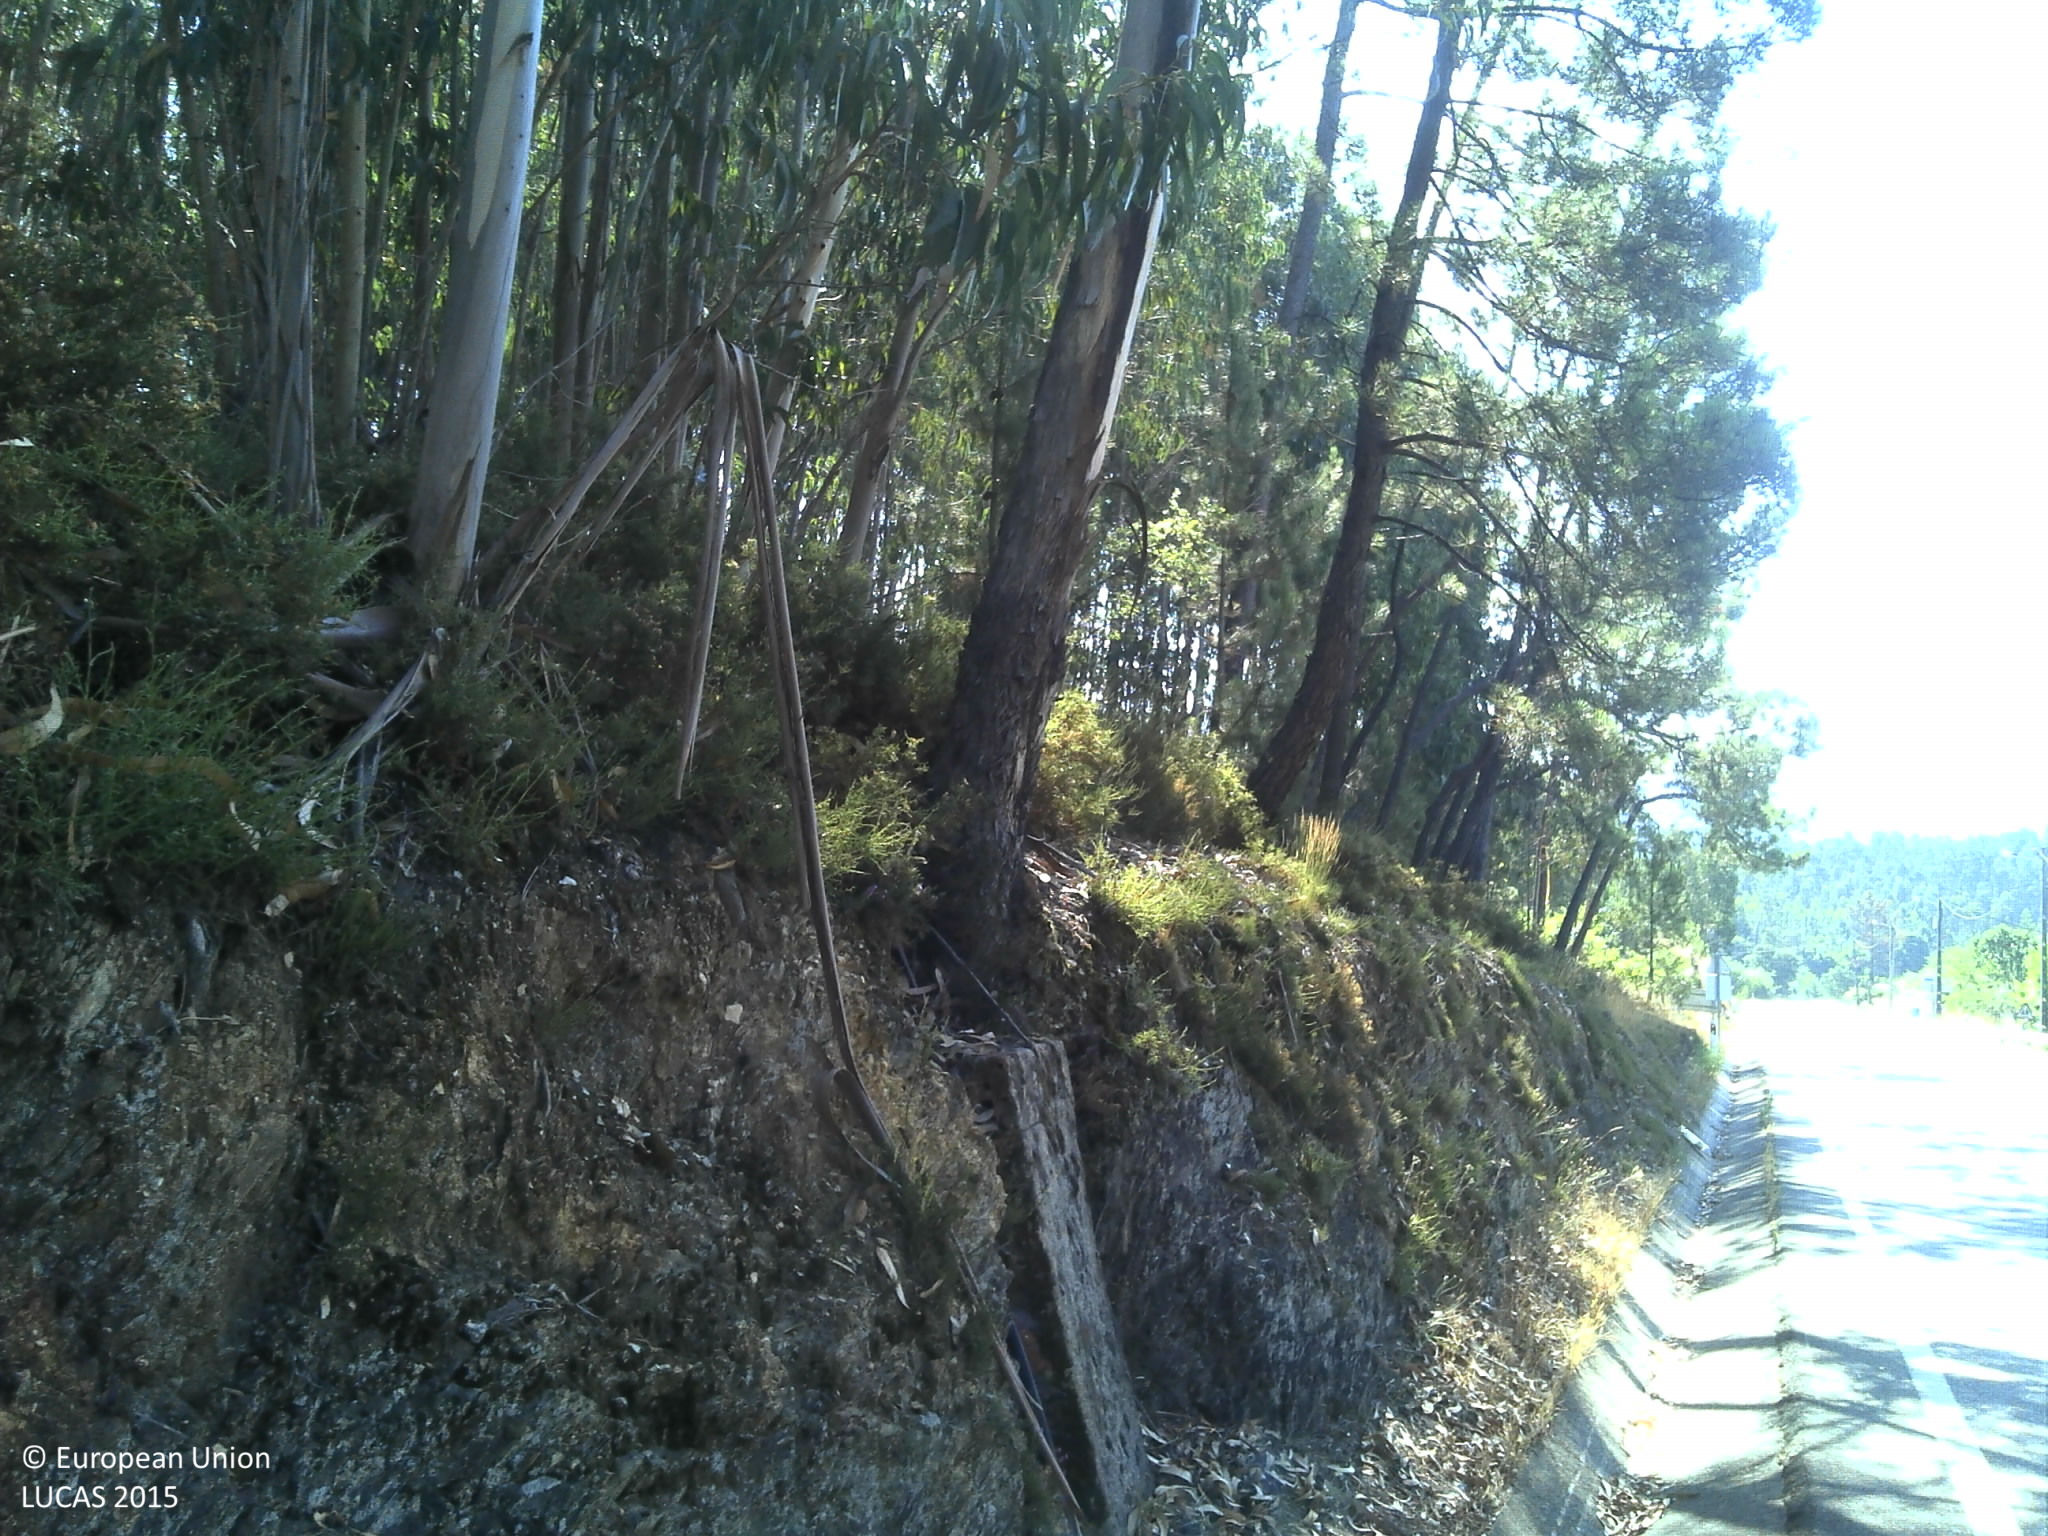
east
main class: Woodland
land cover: Broadleaved woodland
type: exotic forest
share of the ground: 50 - 75 %
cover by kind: broadleaved forest trees 70 %, shrubs 20 %, unconsolidated bare surface 10 %
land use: Forestry
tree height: > 5 m
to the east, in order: Broadleaved woodland; Fences; Grass margins; Arable land (only in case pi); Permanent crops (only in case pi); Arable land (only in case pi); Permanent crops (only in case pi); Broadleaved woodland; Electric lines; Broadleaved woodland; Pine dominated coniferous woodland; Tracks; Broadleaved woodland
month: July
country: PT
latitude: 40.4696
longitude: -8.3071
